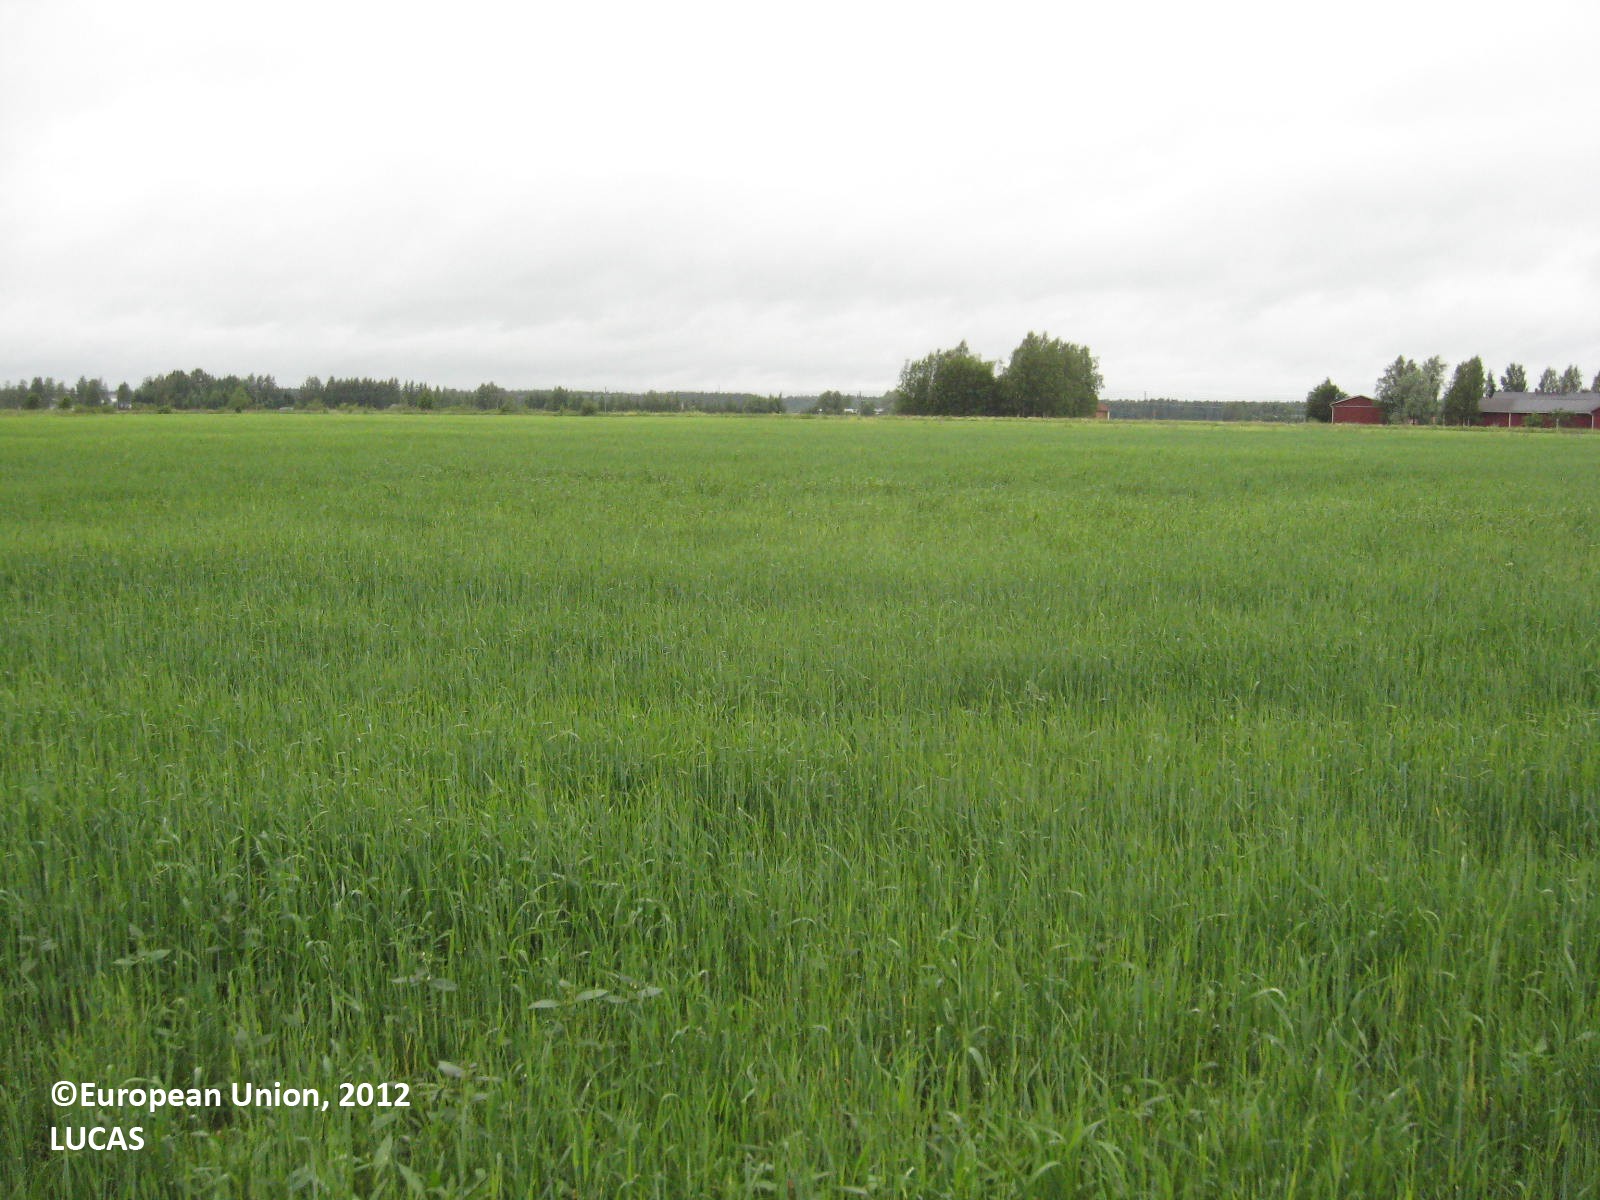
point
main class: Cropland
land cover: Barley
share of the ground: > 75 %
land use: Agriculture (excluding fallow land and kitchen gardens)
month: July
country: FI
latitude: 62.4652
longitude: 21.6992
